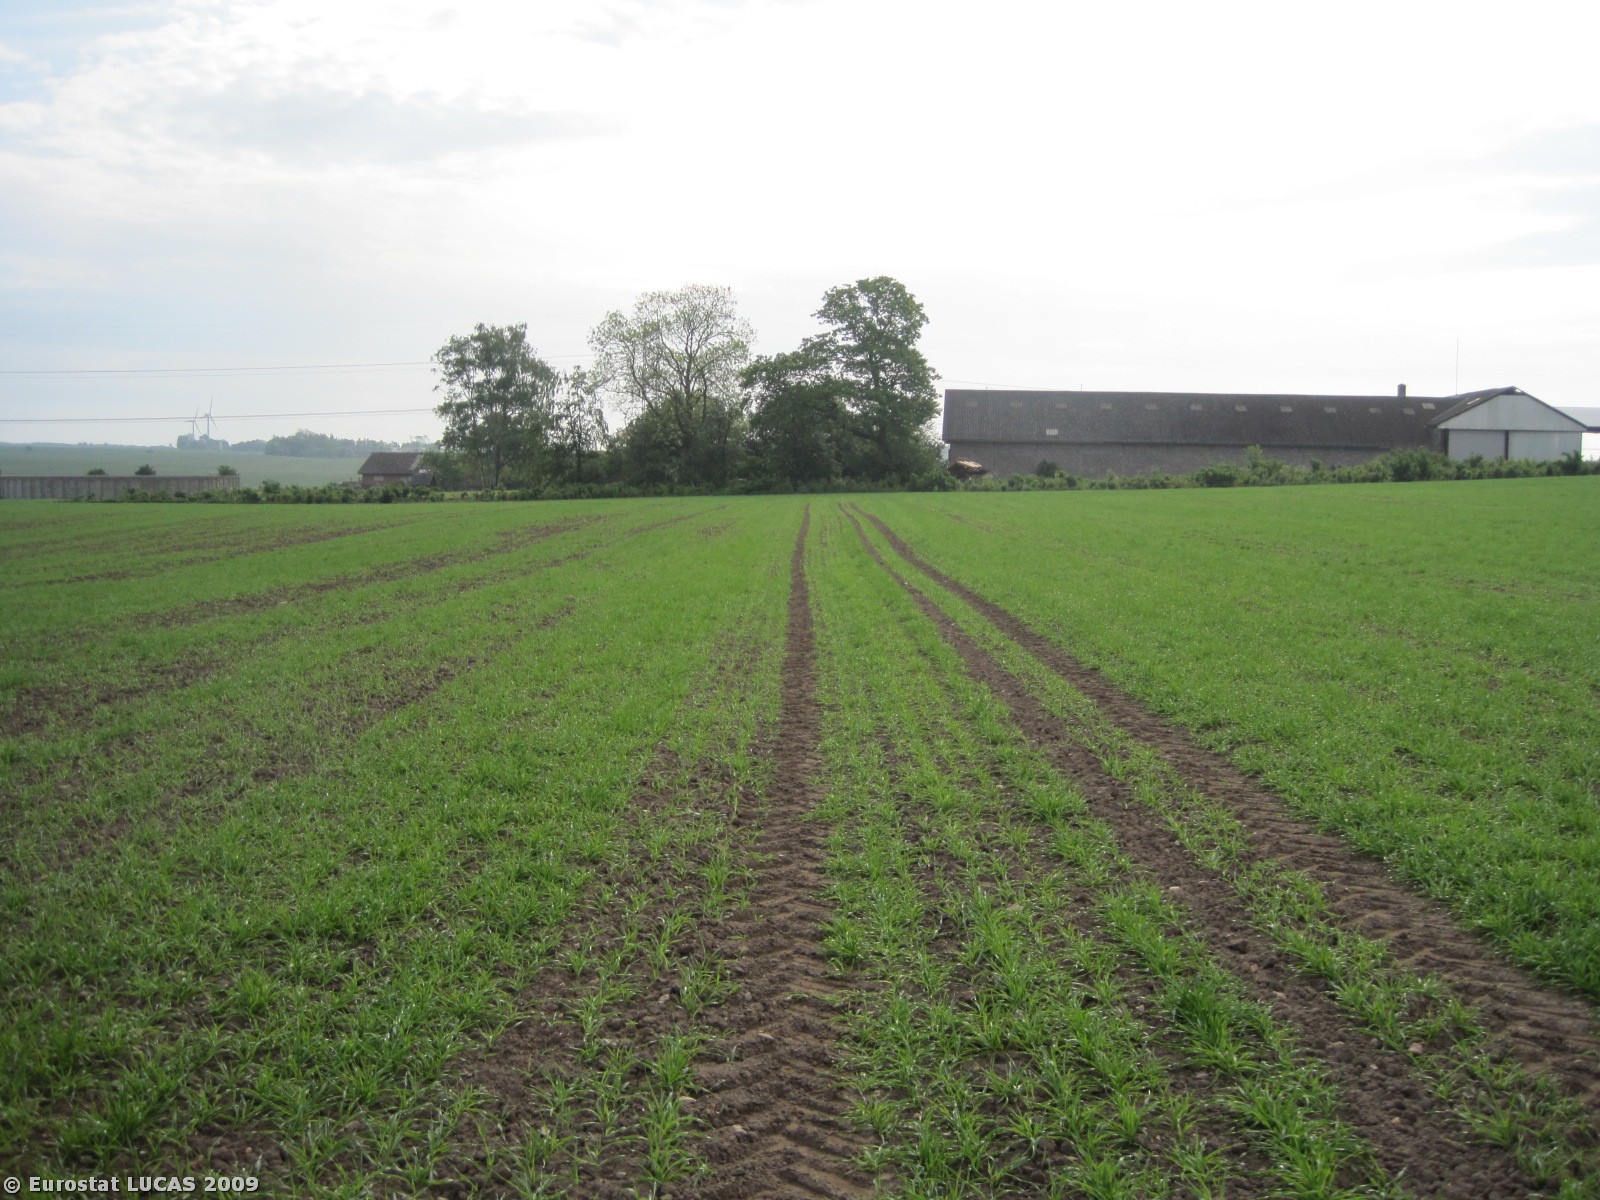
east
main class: Cropland
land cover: Barley
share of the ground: > 75 %
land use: Agriculture (excluding fallow land and kitchen gardens)
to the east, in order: Barley; Shrubland with sparse tree cover; Single bushes/trees; Grassland without tree/shrub cover; Tracks; Broadleaved woodland; Grassland without tree/shrub cover; Artificial constructions in urban areas; Grassland without tree/shrub cover
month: May
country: DK
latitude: 56.3855
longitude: 10.0162
